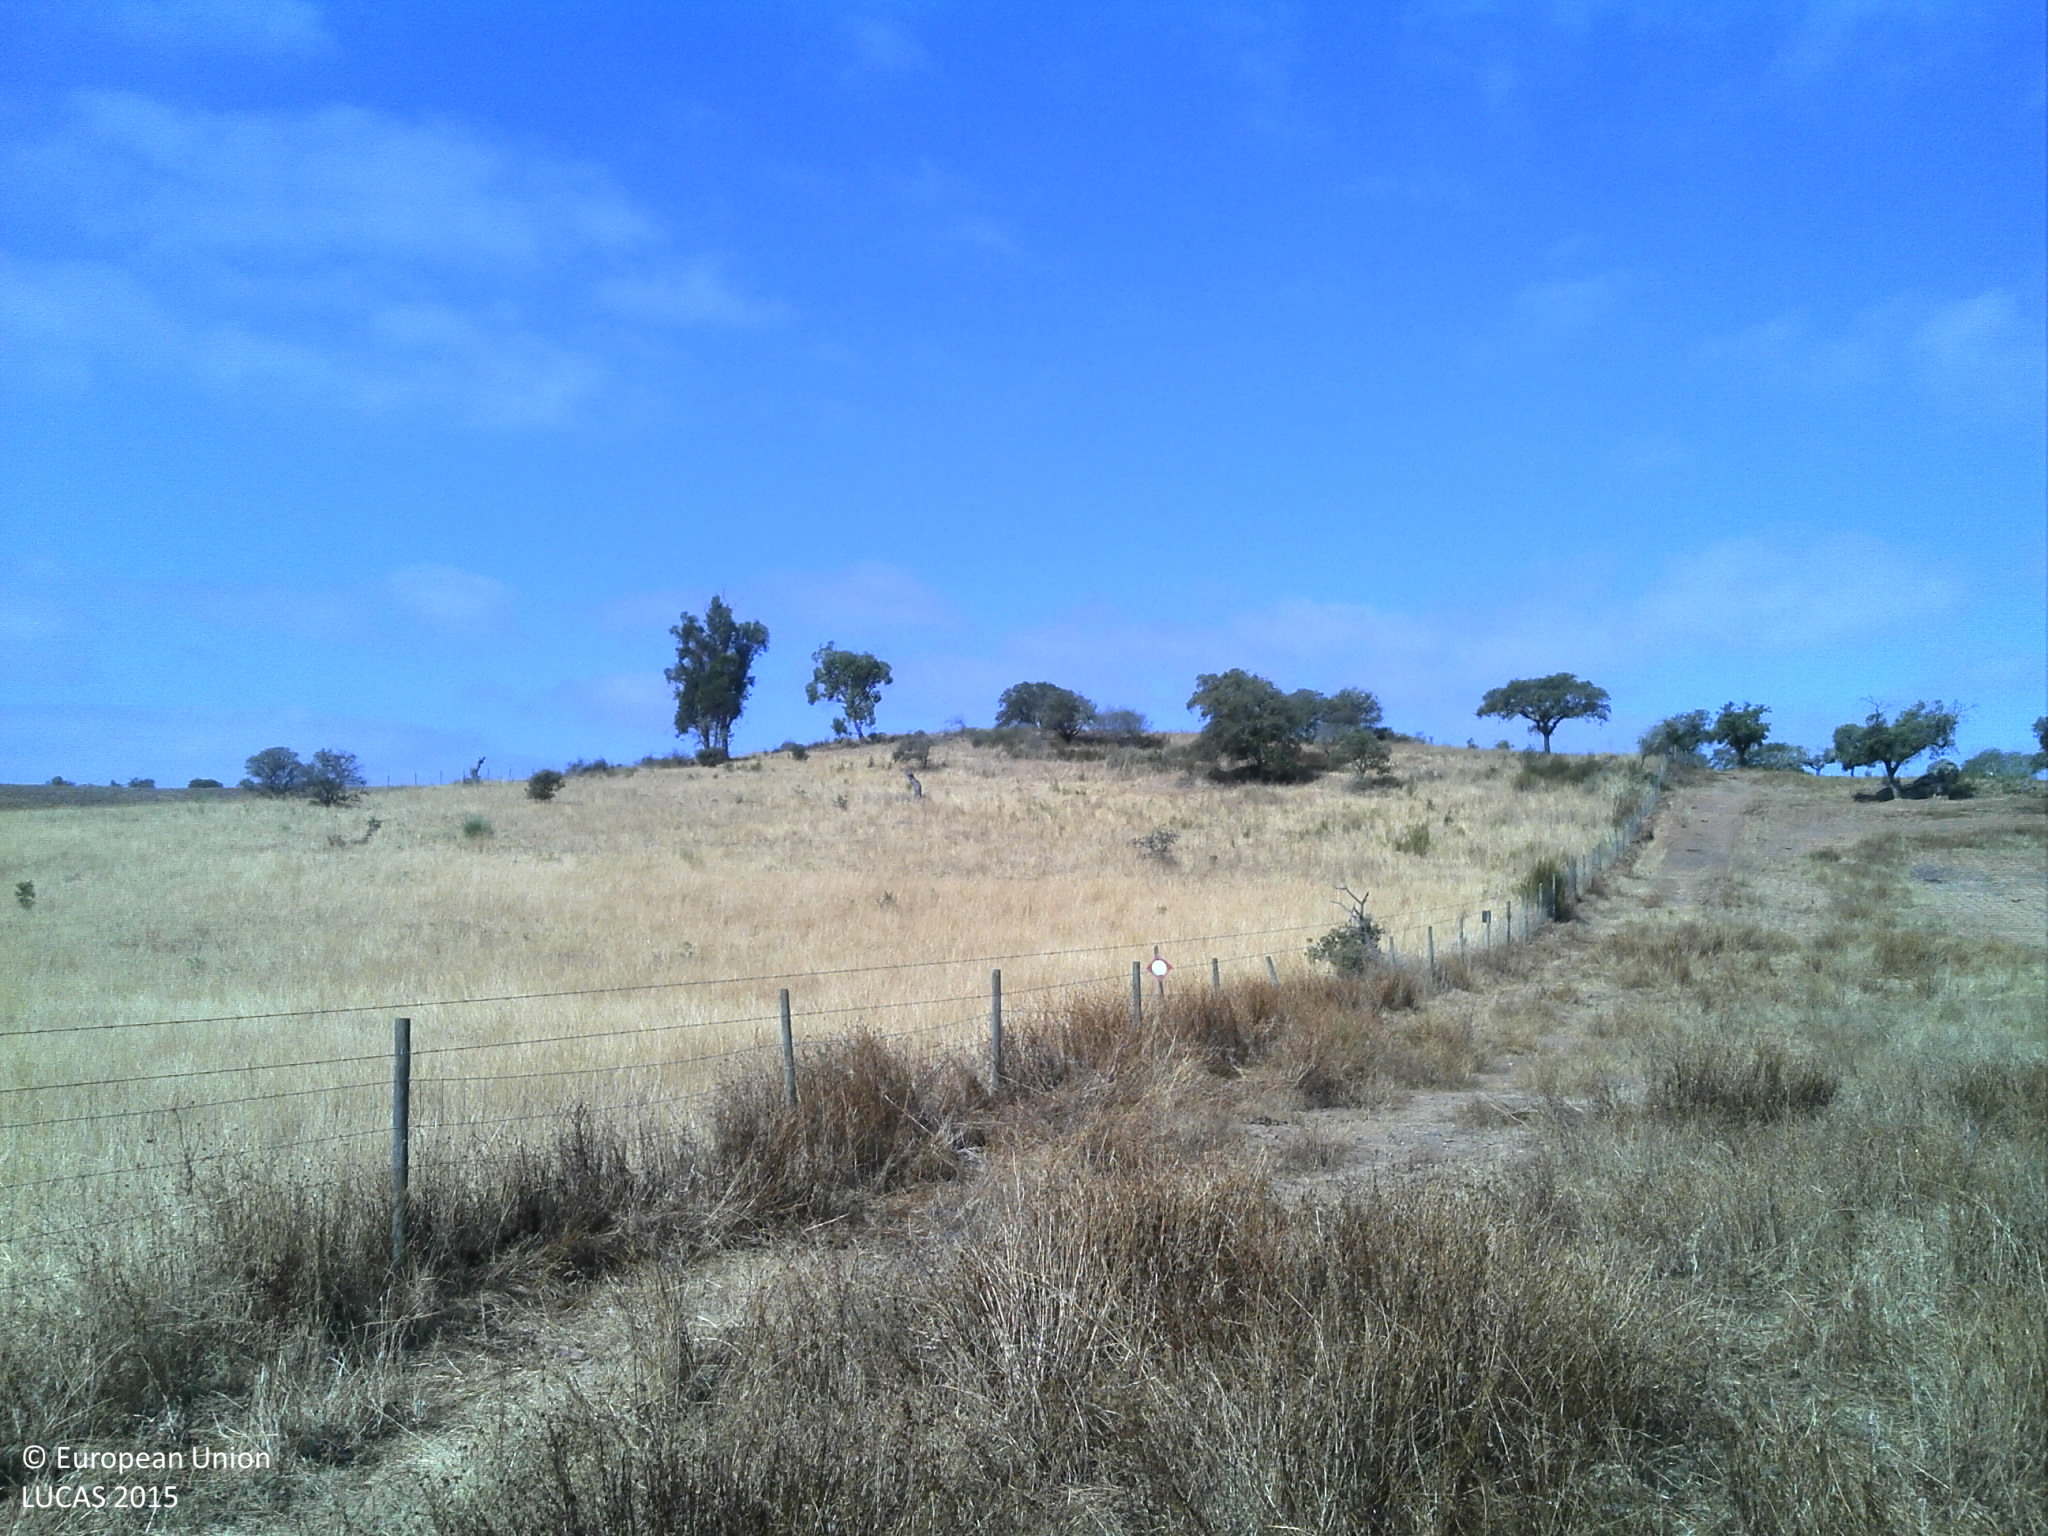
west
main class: Grassland
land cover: Grassland without tree/shrub cover
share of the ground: 25 - 50 %
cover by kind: unconsolidated bare surface 60 %, herbaceous plants 40 %
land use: Agriculture (excluding fallow land and kitchen gardens)
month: July
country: PT
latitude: 38.4477
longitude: -7.3605
